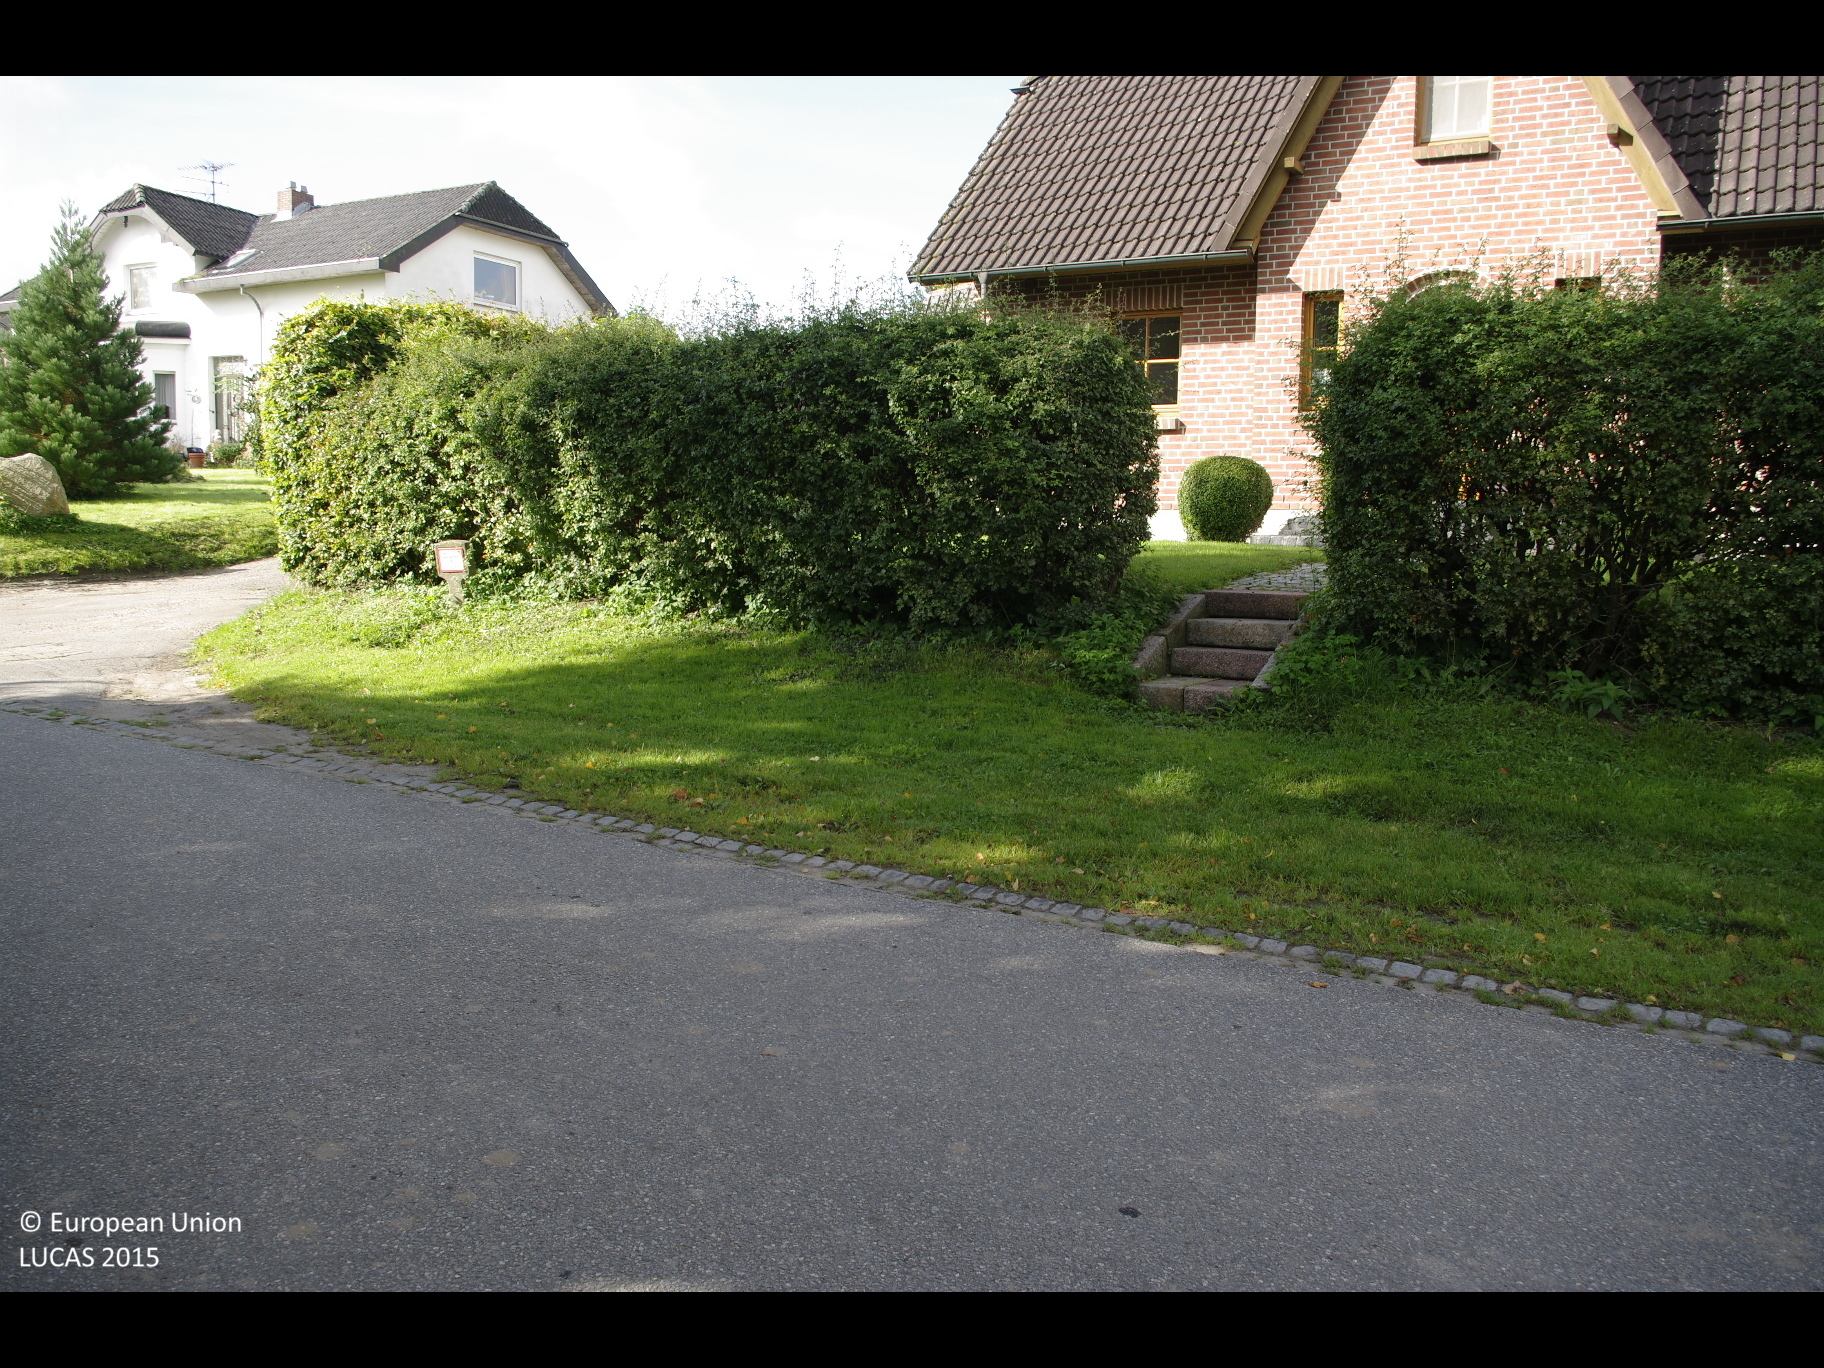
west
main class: Woodland
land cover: Other mixed woodland
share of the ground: > 75 %
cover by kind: coniferous forest trees 50 %, broadleaved forest trees 40 %, shrubs 10 %
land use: Residential
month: September
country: DE
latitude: 53.9934
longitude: 10.6250
